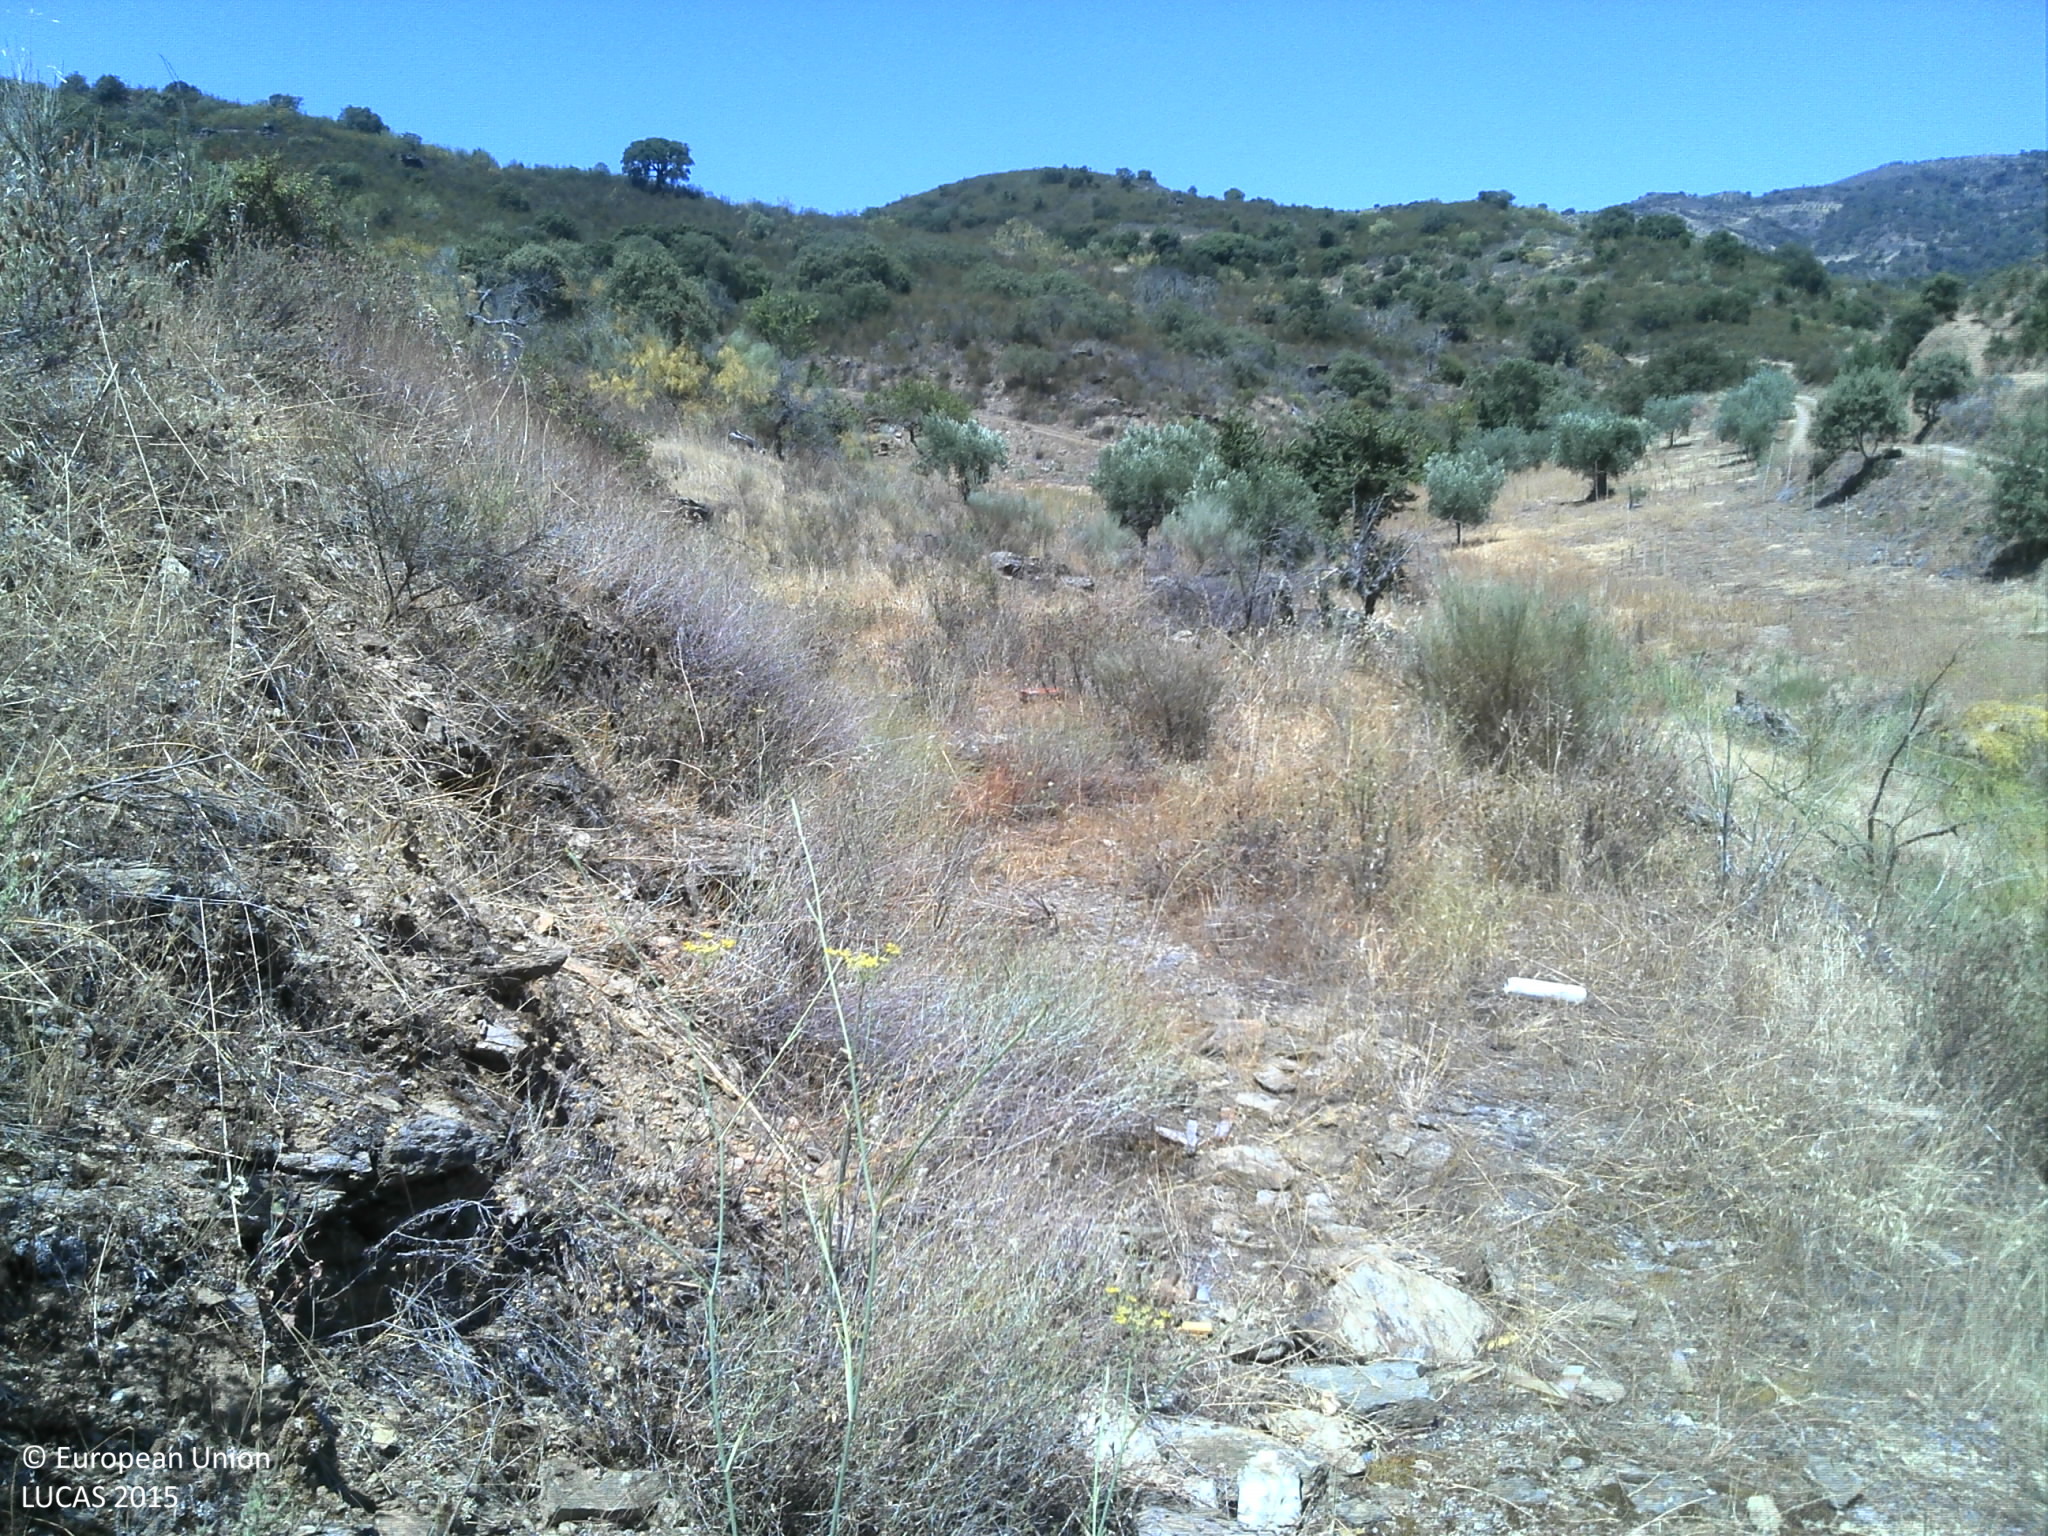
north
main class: Shrubland
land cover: Shrubland with sparse tree cover
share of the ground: > 75 %
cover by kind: shrubs 65 %, unconsolidated bare surface 20 %, herbaceous plants 10 %, broadleaved forest trees 5 %
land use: Abandoned areas
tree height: > 5 m
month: July
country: PT
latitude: 41.3652
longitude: -7.0291
